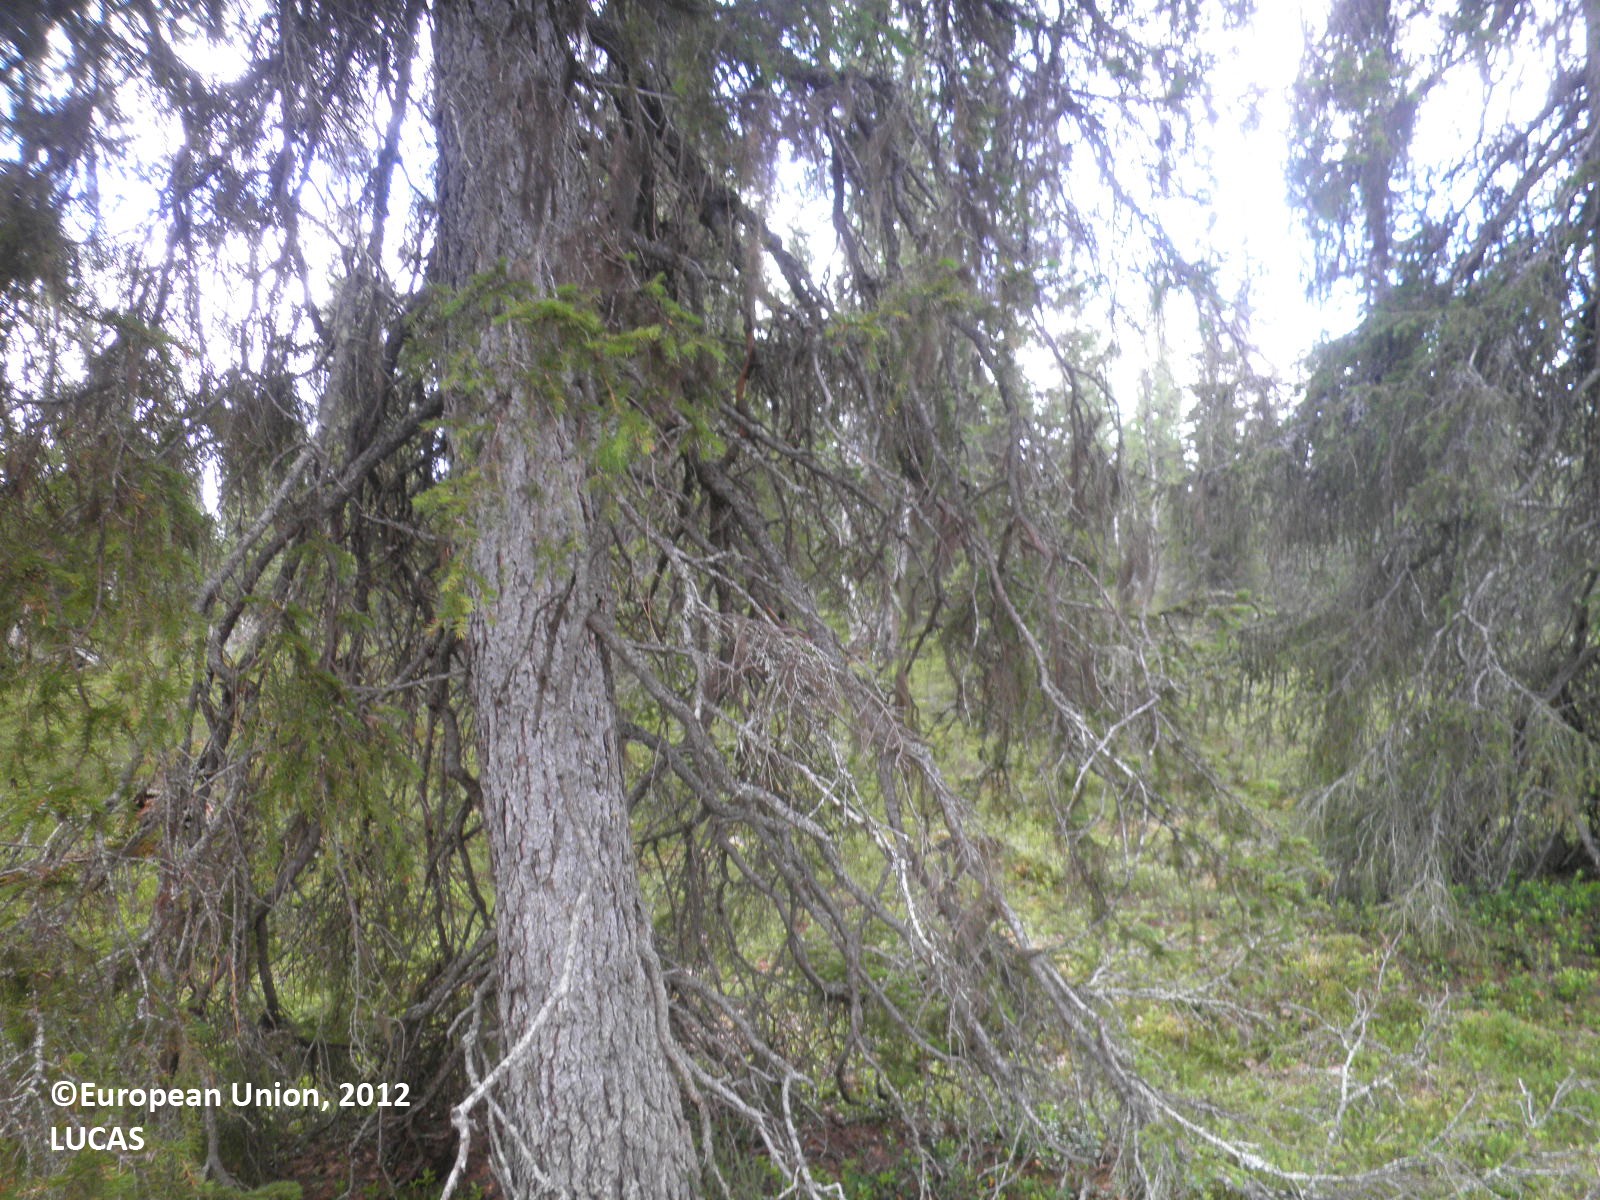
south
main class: Woodland
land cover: Spruce dominated mixed woodland
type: boreal forest
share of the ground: 50 - 75 %
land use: Forestry
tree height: > 5 m
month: July
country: FI
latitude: 67.9613
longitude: 26.1758
